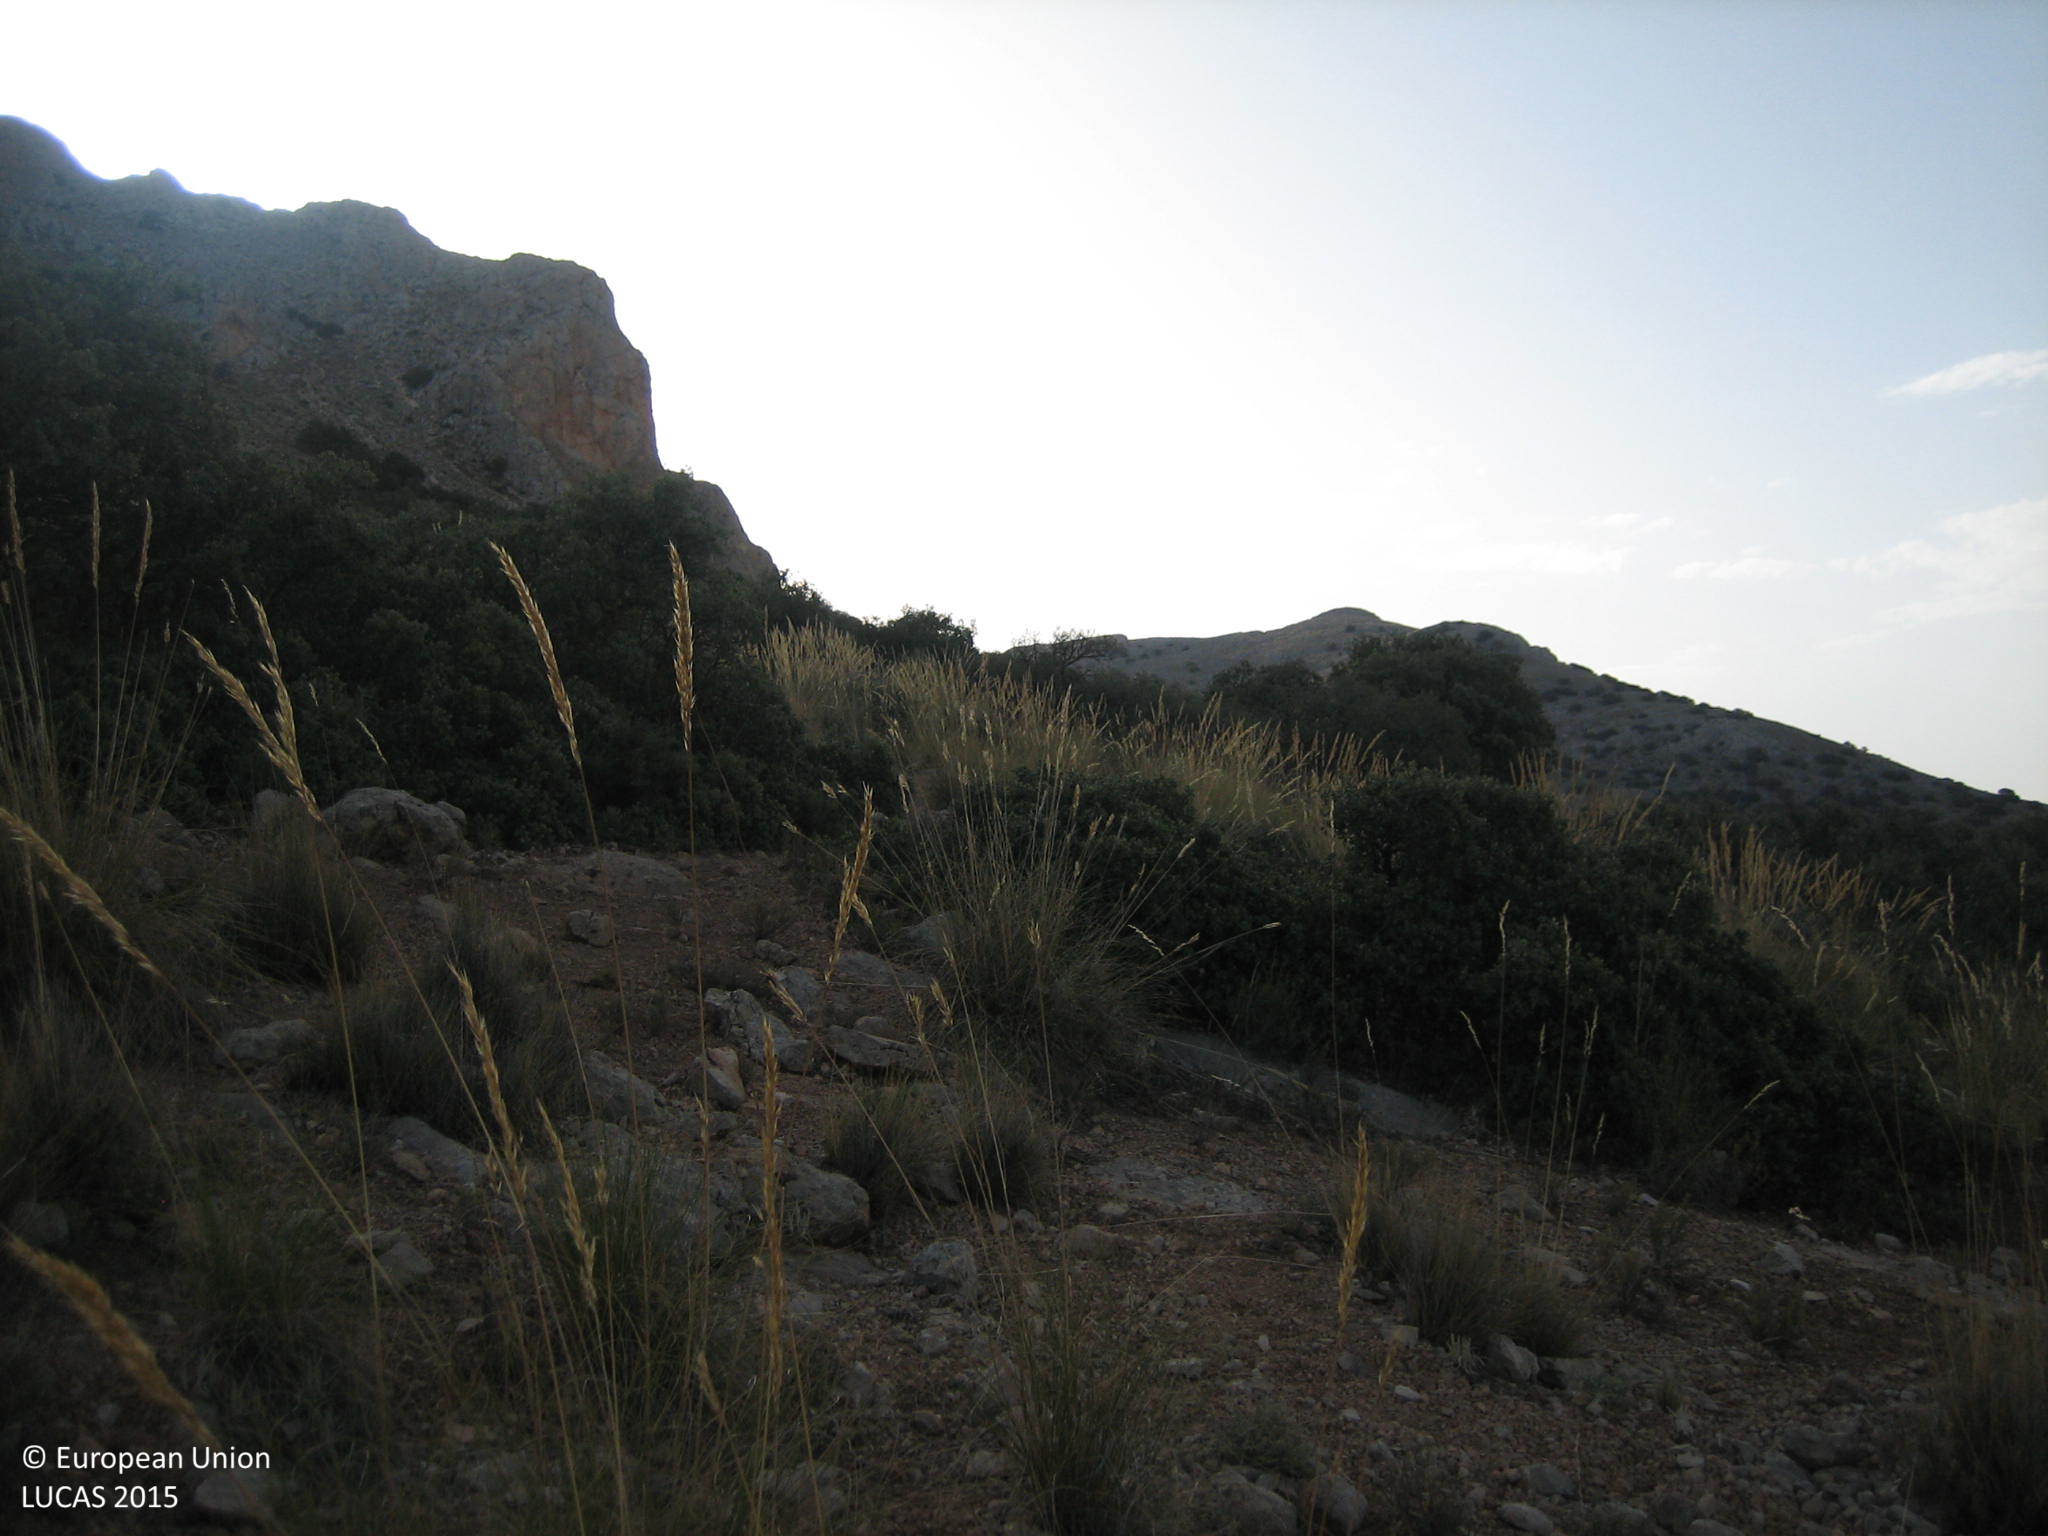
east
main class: Shrubland
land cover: Shrubland with sparse tree cover
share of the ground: 10 - 25 %
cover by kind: herbaceous plants 45 %, consolidated bare surface 30 %, shrubs 20 %, broadleaved forest trees 5 %
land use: Agriculture (excluding fallow land and kitchen gardens)
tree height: < 5 m
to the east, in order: Shrubland with sparse tree cover; Broadleaved woodland
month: July
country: ES
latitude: 37.6176
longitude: -2.3461
